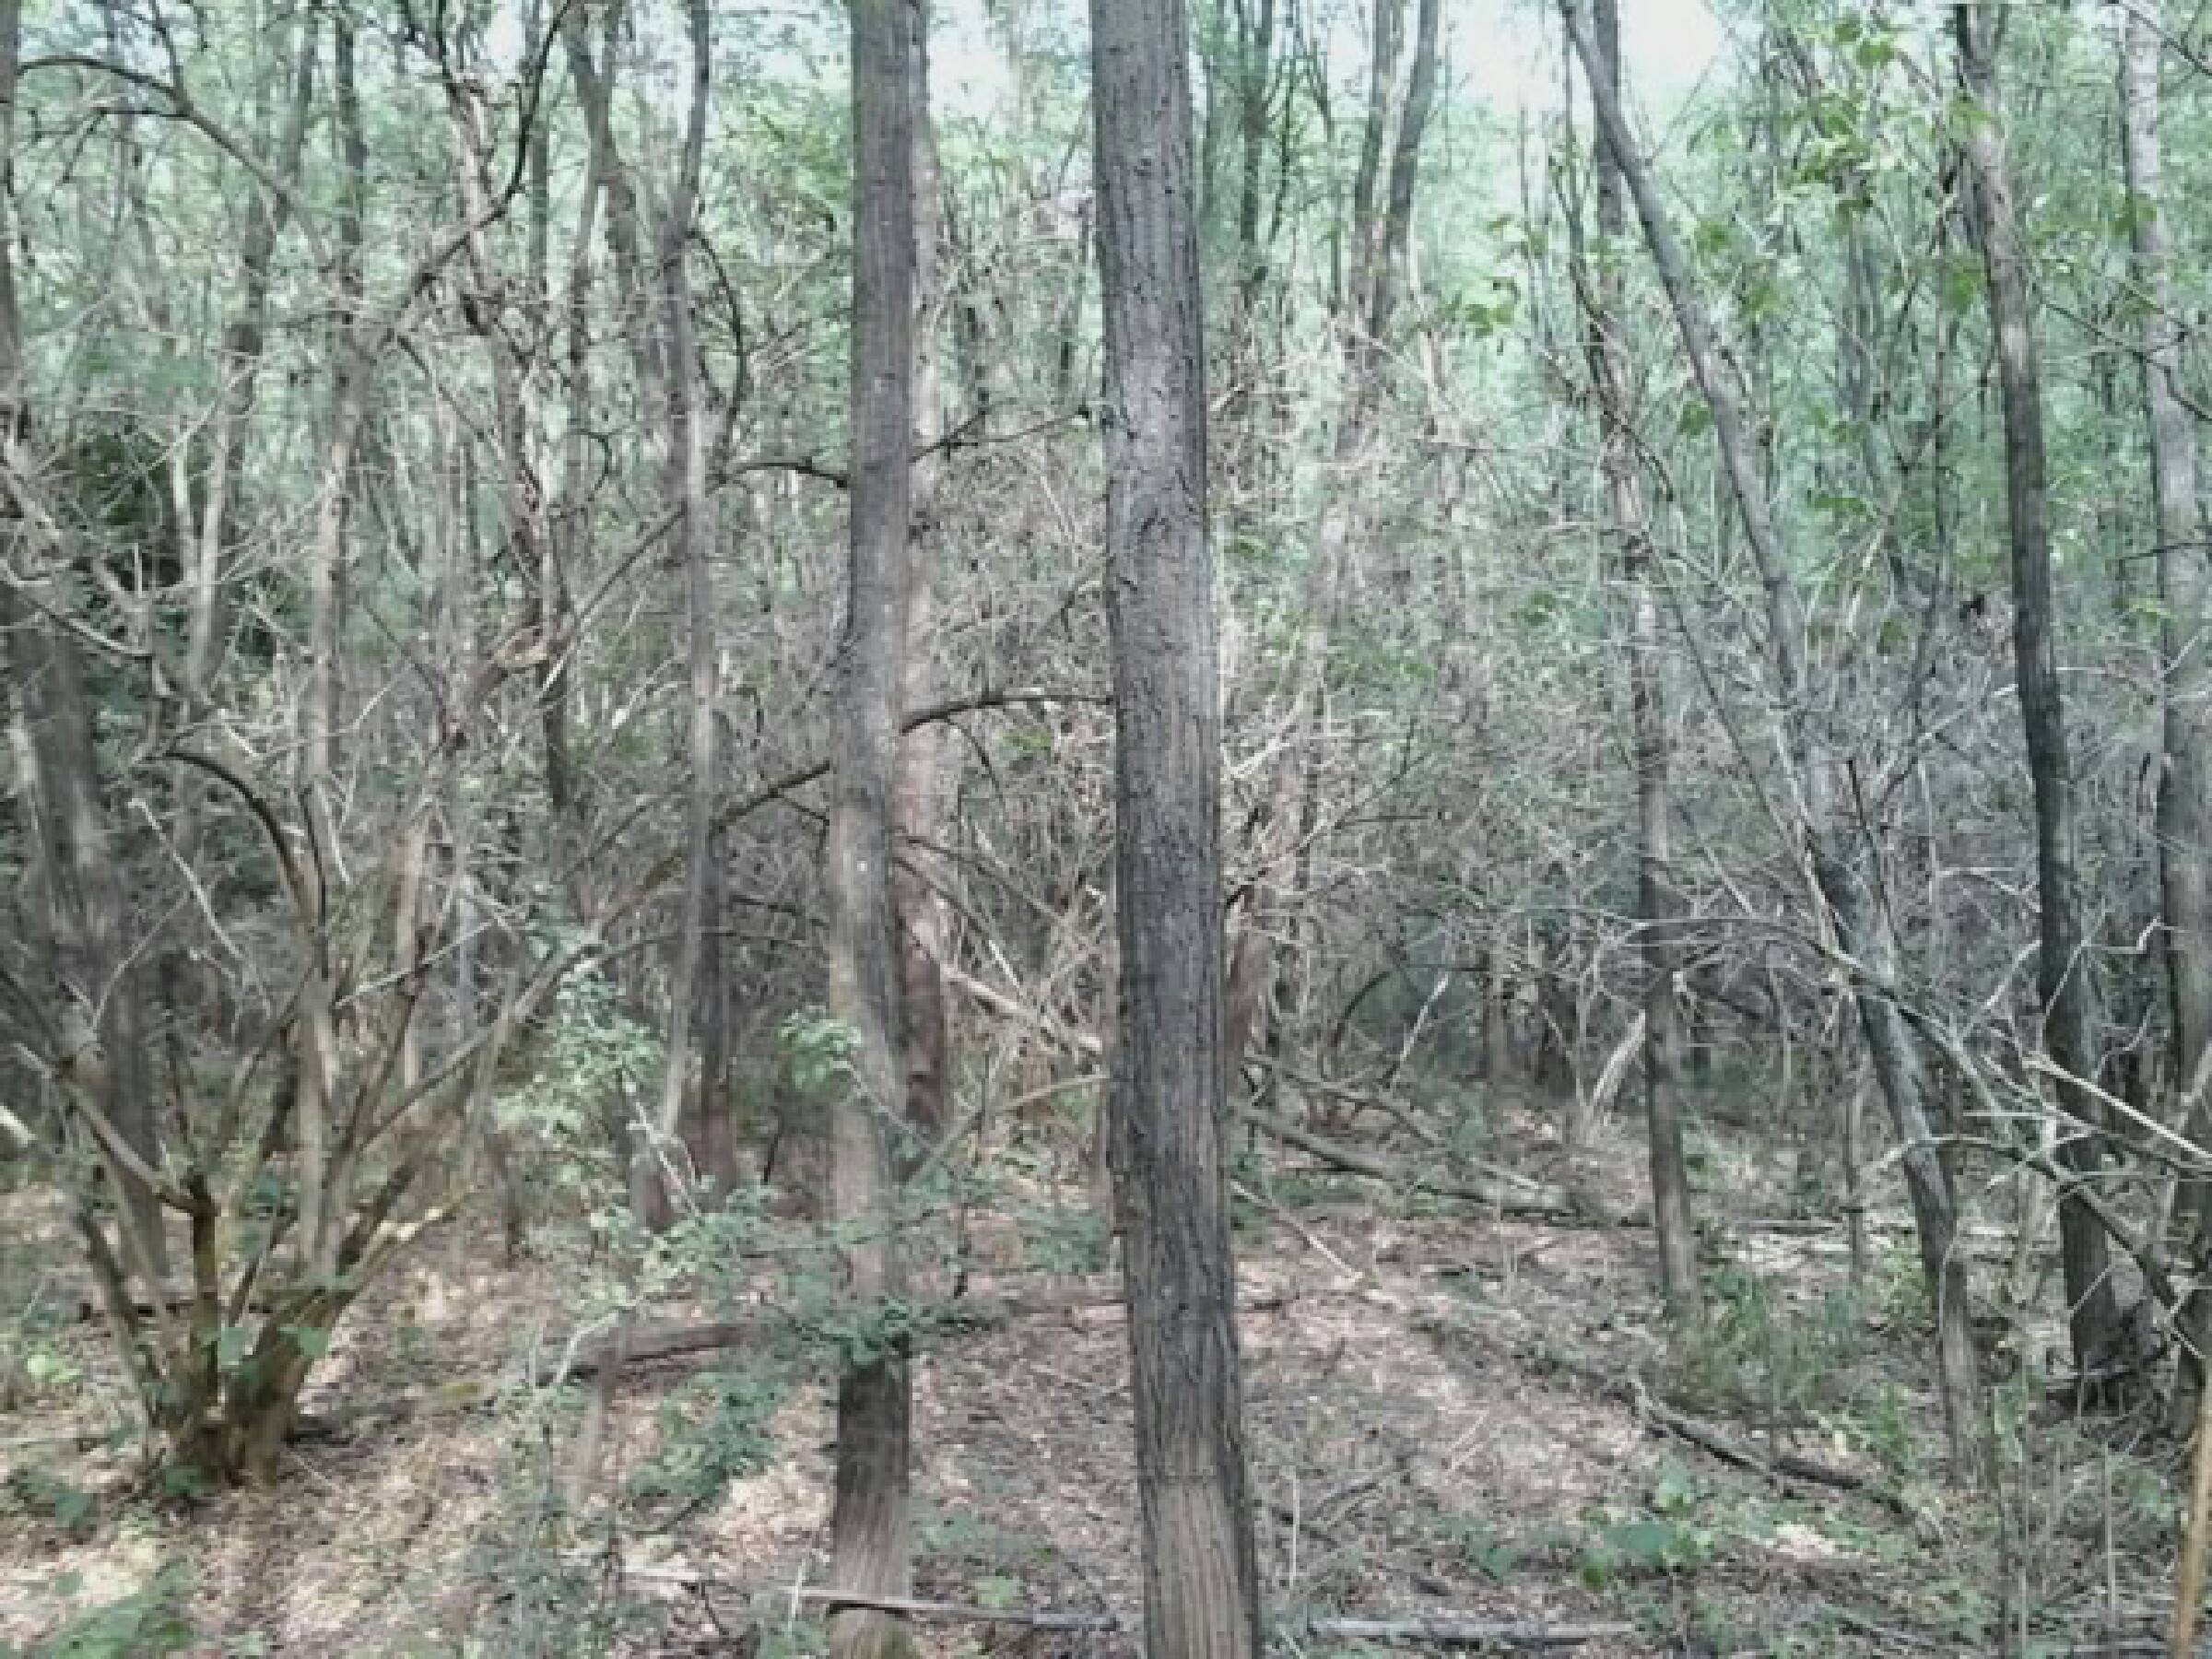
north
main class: Woodland
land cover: Broadleaved woodland
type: exotic forest
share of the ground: > 75 %
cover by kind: broadleaved forest trees 100 %
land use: Forestry
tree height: > 5 m
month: August
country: HU
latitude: 47.8535
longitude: 19.4446
